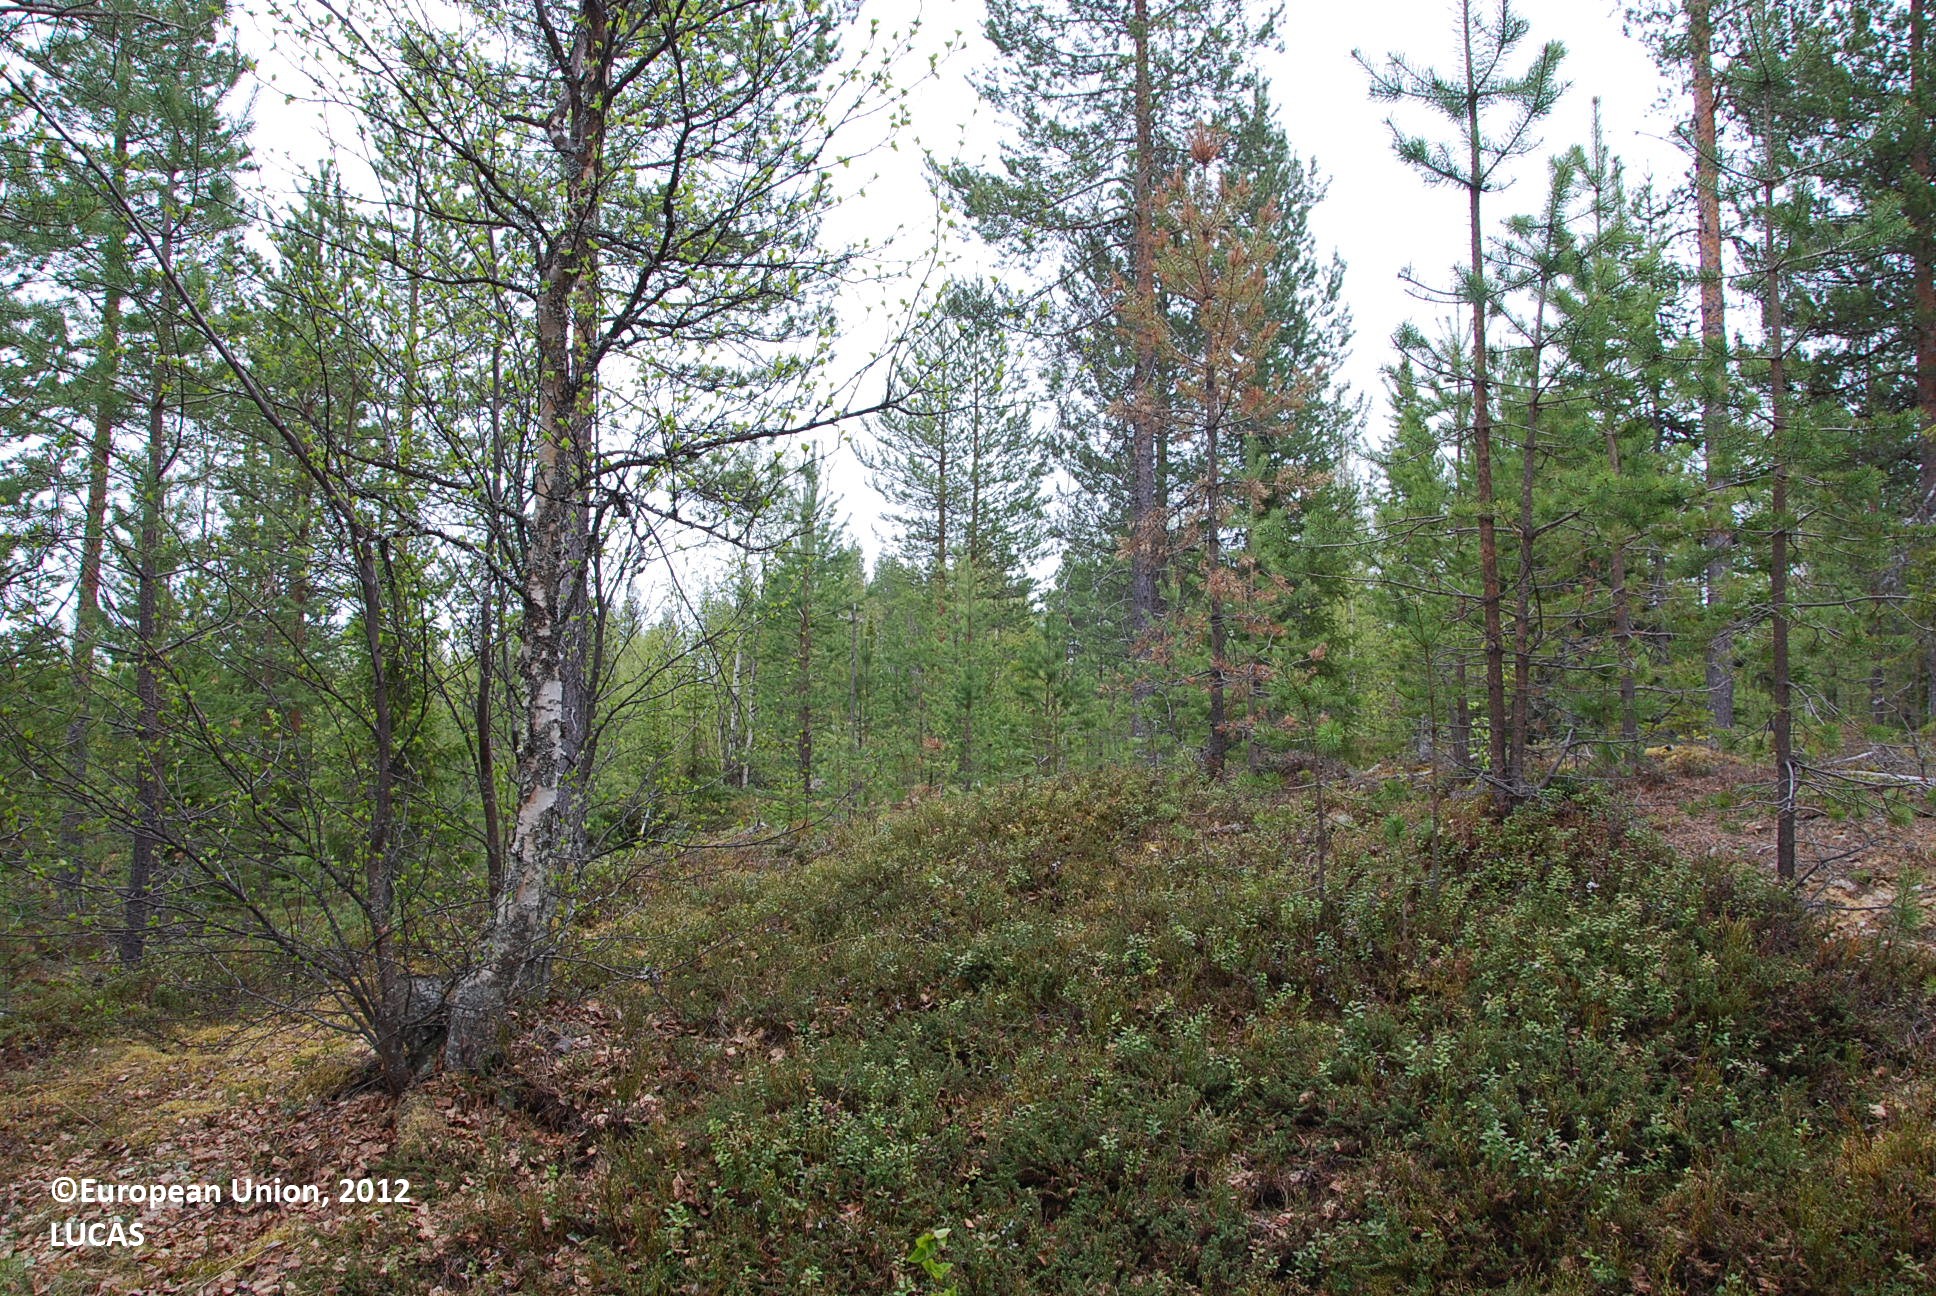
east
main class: Woodland
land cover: Pine dominated coniferous woodland
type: boreal forest
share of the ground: > 75 %
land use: Forestry
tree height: > 5 m
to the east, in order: Pine dominated coniferous woodland; Peatbogs; Pine dominated coniferous woodland
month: June
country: FI
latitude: 66.7874
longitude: 28.2066
